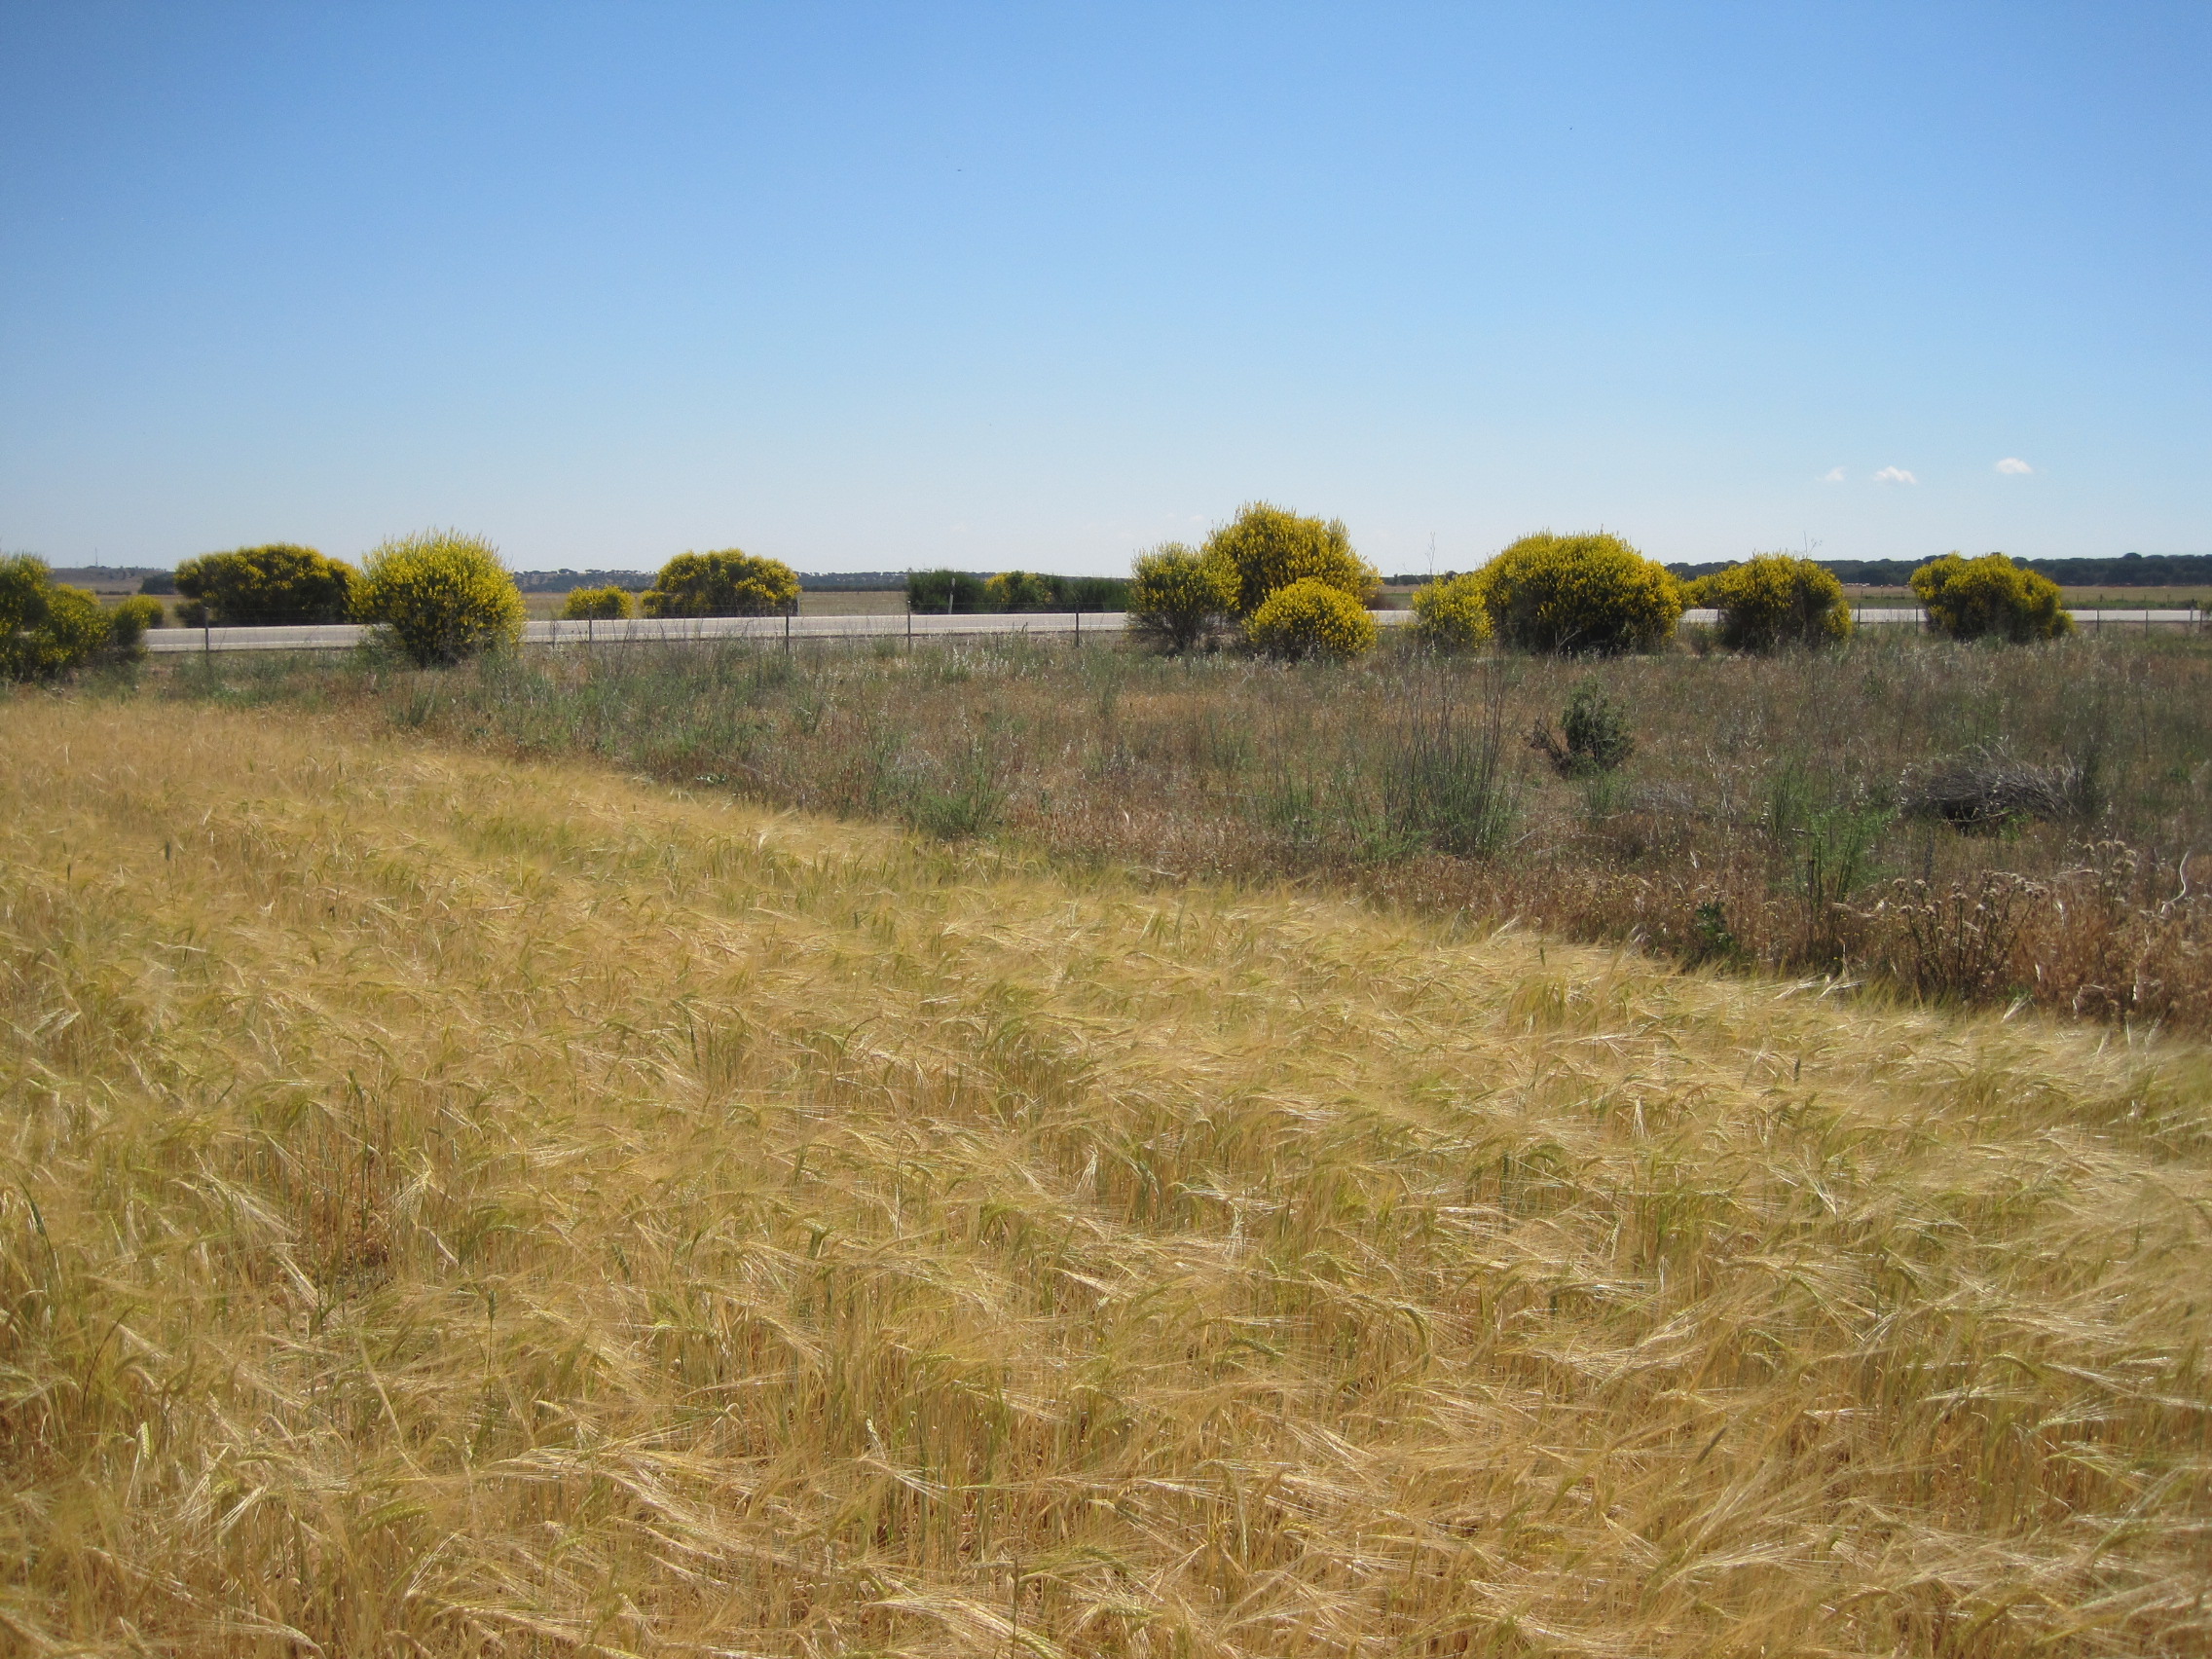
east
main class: Cropland
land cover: Barley
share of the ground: > 75 %
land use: Agriculture (excluding fallow land and kitchen gardens)
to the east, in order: Barley; Grassland without tree/shrub cover; Tracks; Grassland with sparse tree/shrub cover; Fences; Paved roads, cycling and walking lanes; Fences; Grassland with sparse tree/shrub cover; Tracks; Grass margins; Oats
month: June
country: ES
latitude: 41.8368
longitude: -5.3893
